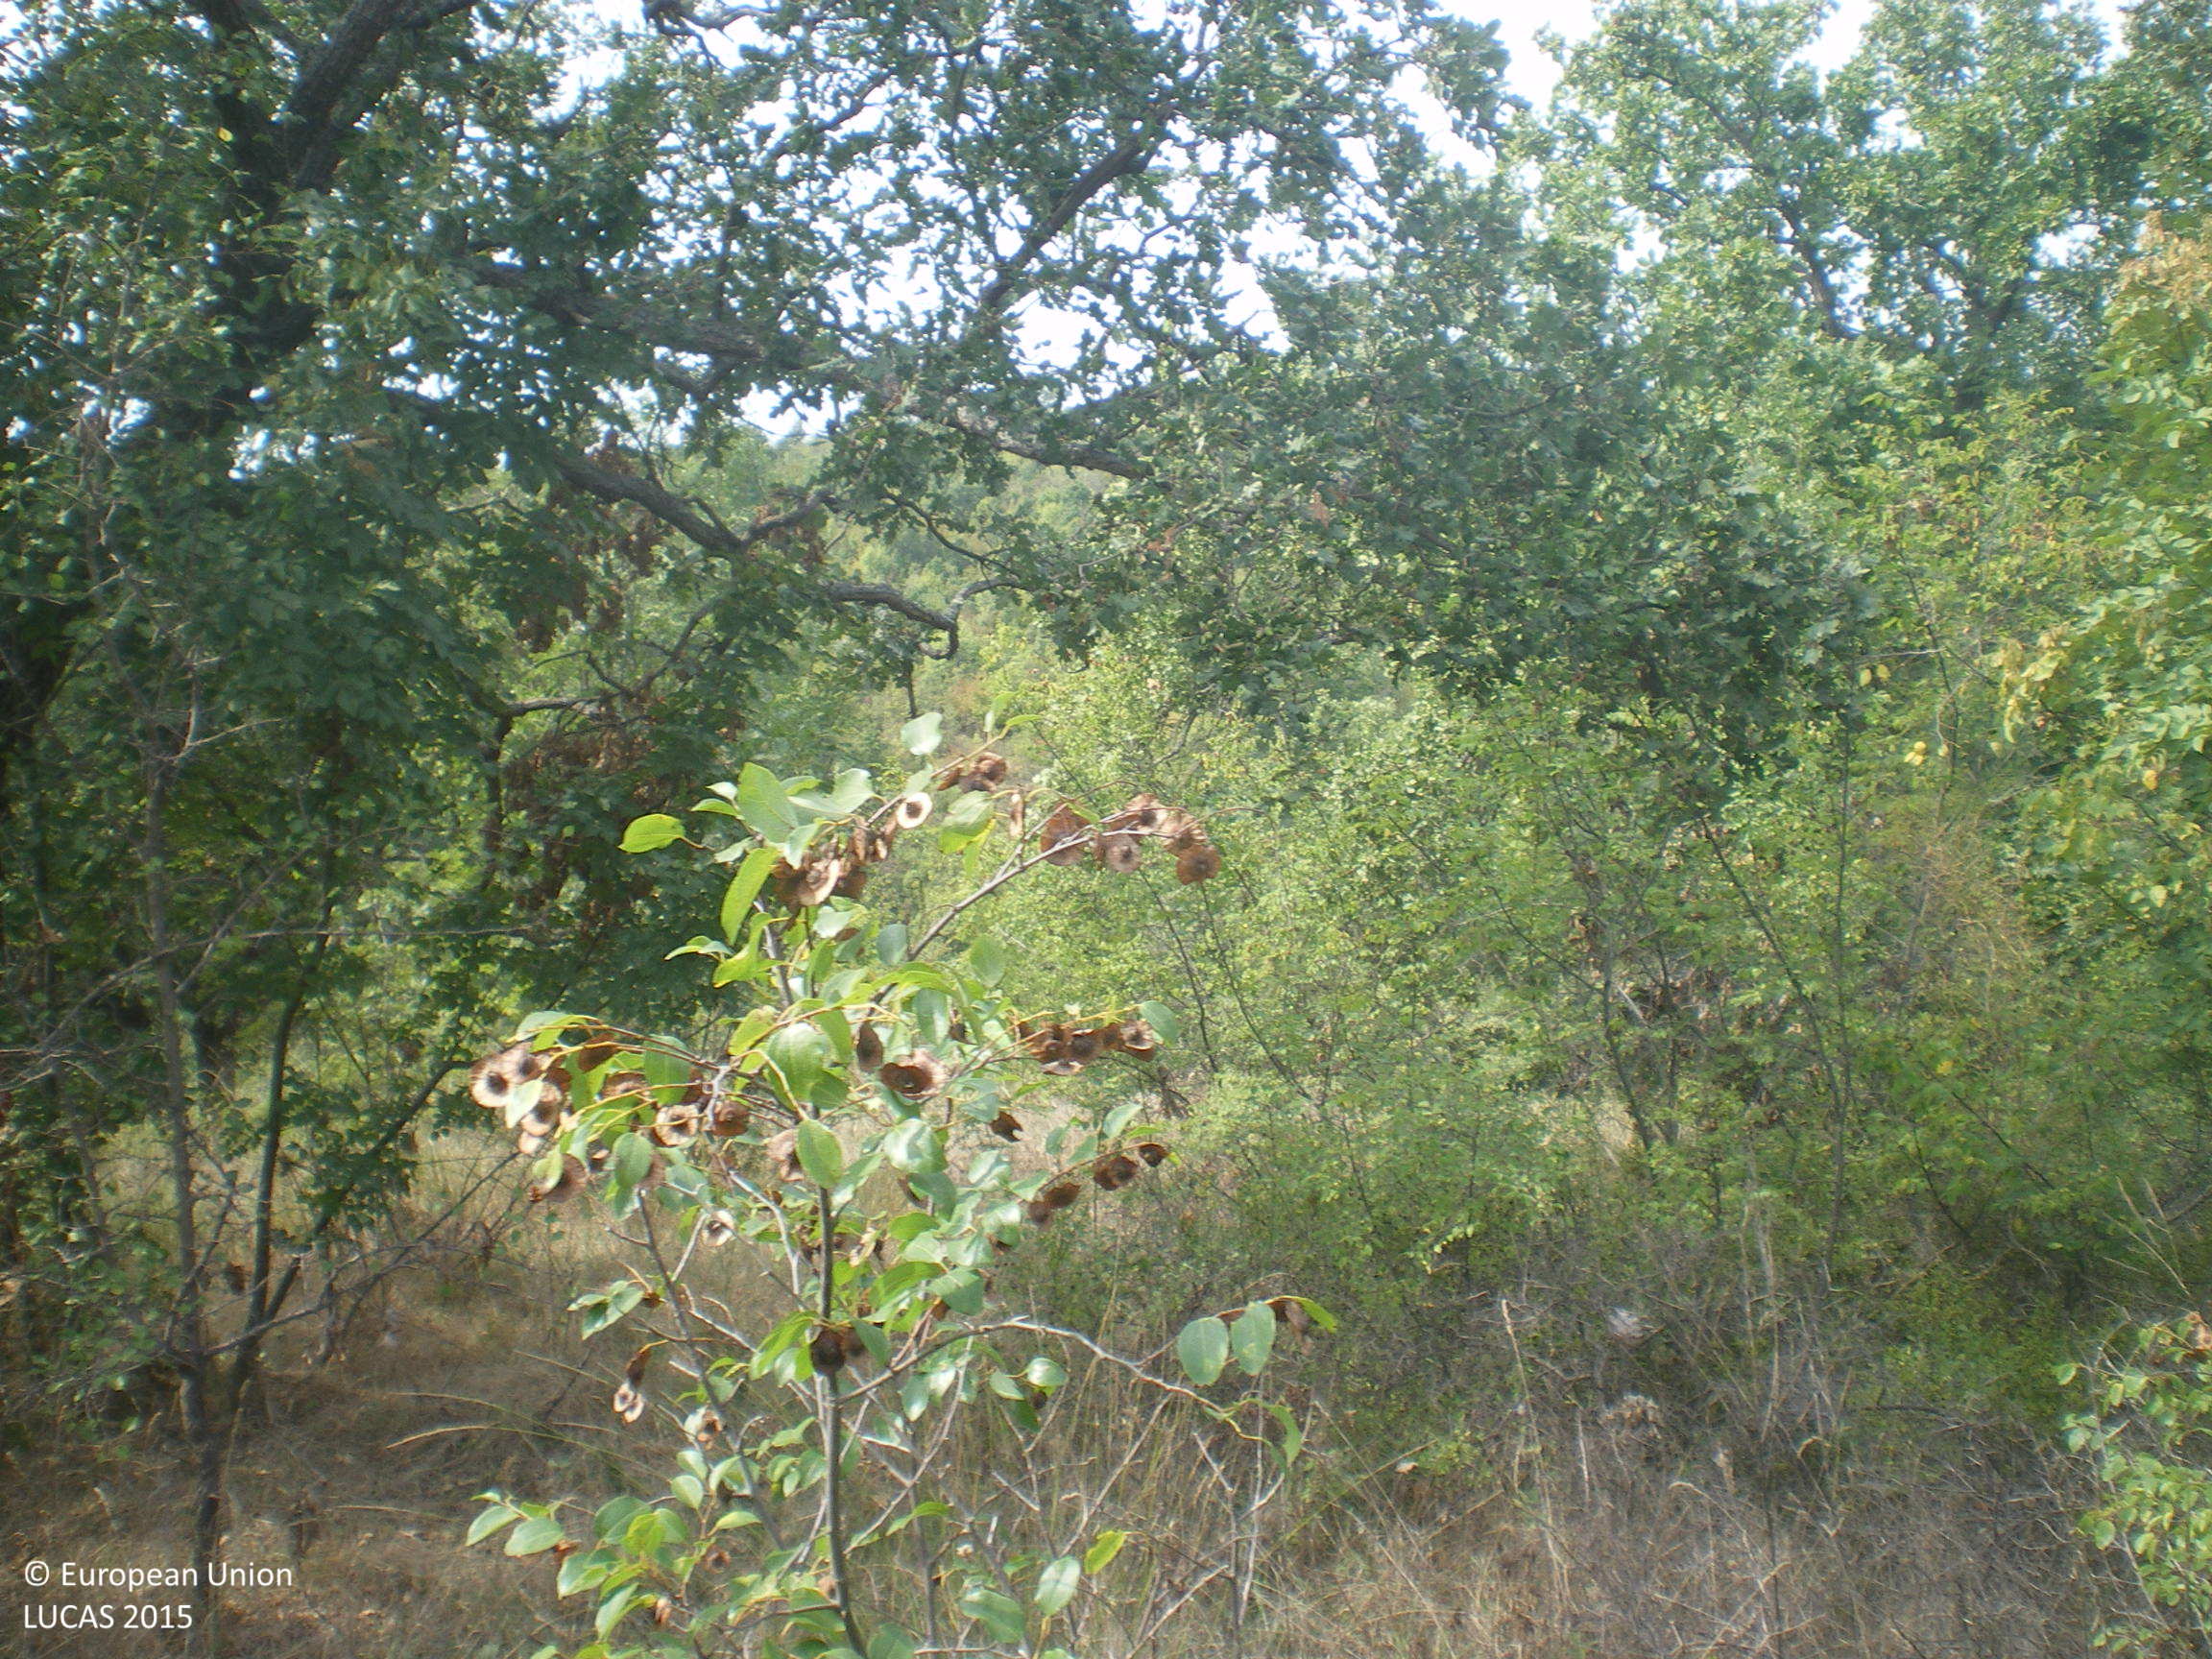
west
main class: Woodland
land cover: Broadleaved woodland
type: mesophytic deciduous forest
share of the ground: > 75 %
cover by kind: broadleaved forest trees 70 %, shrubs 20 %, herbaceous plants 10 %
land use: Semi-natural and natural areas not in use
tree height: > 5 m
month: September
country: BG
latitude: 41.8605
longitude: 25.9365
